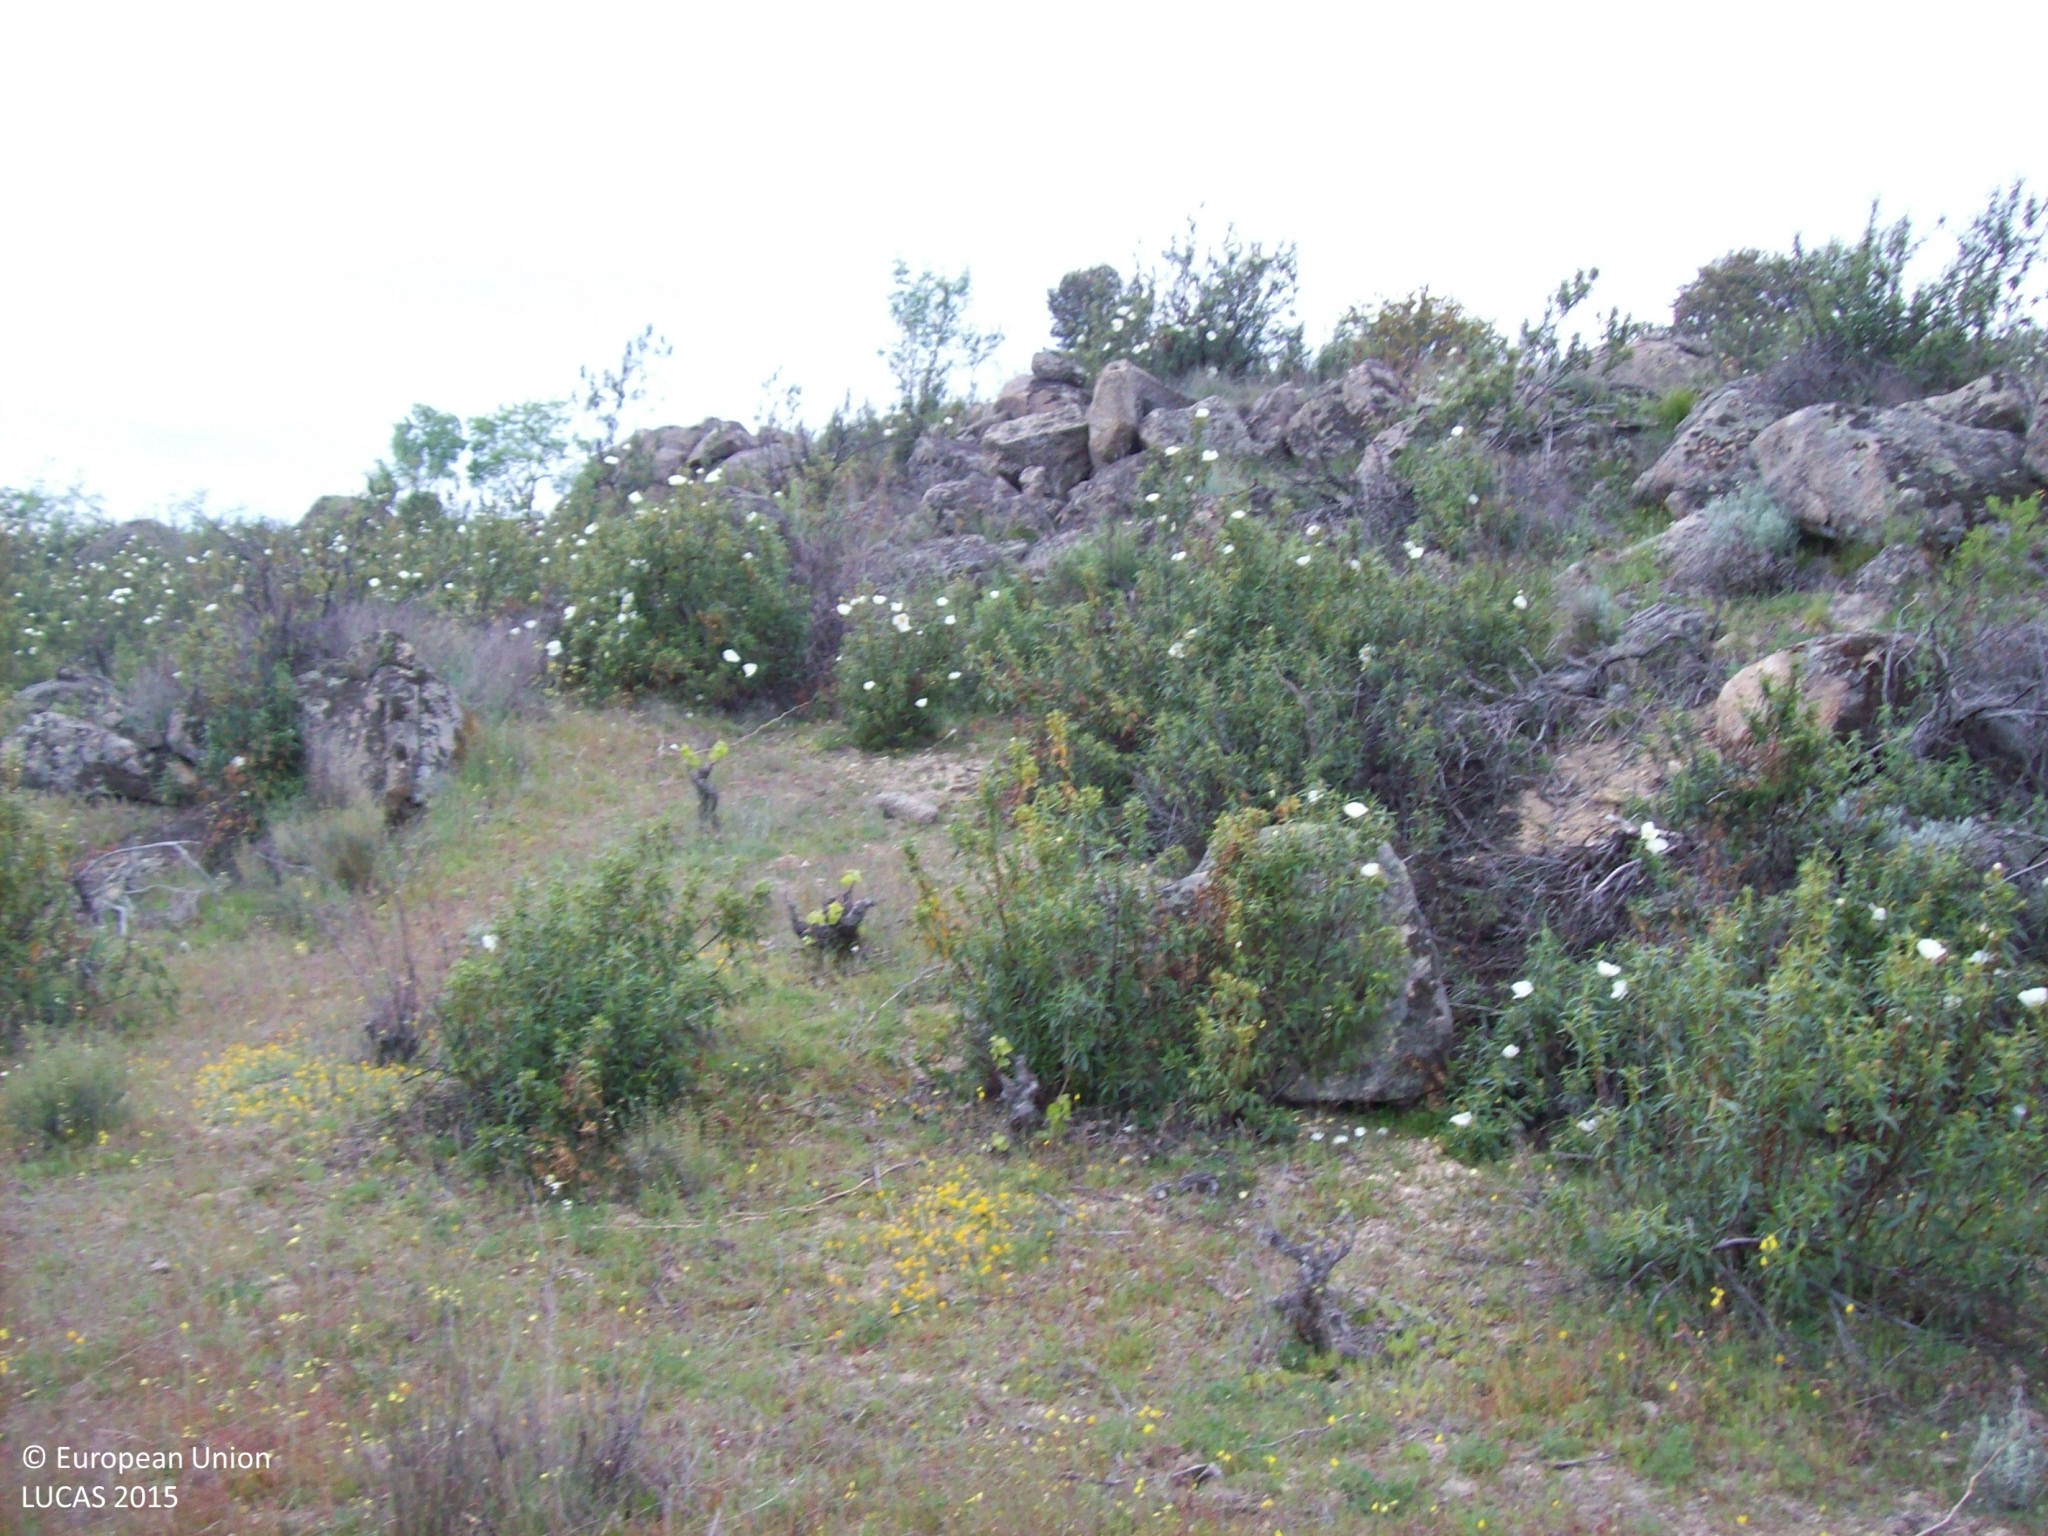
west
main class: Cropland
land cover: Vineyards
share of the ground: 10 - 25 %
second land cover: Shrubland without tree cover
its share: 25 - 50 %
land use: Abandoned areas
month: April
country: ES
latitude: 40.4018
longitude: -4.8175
